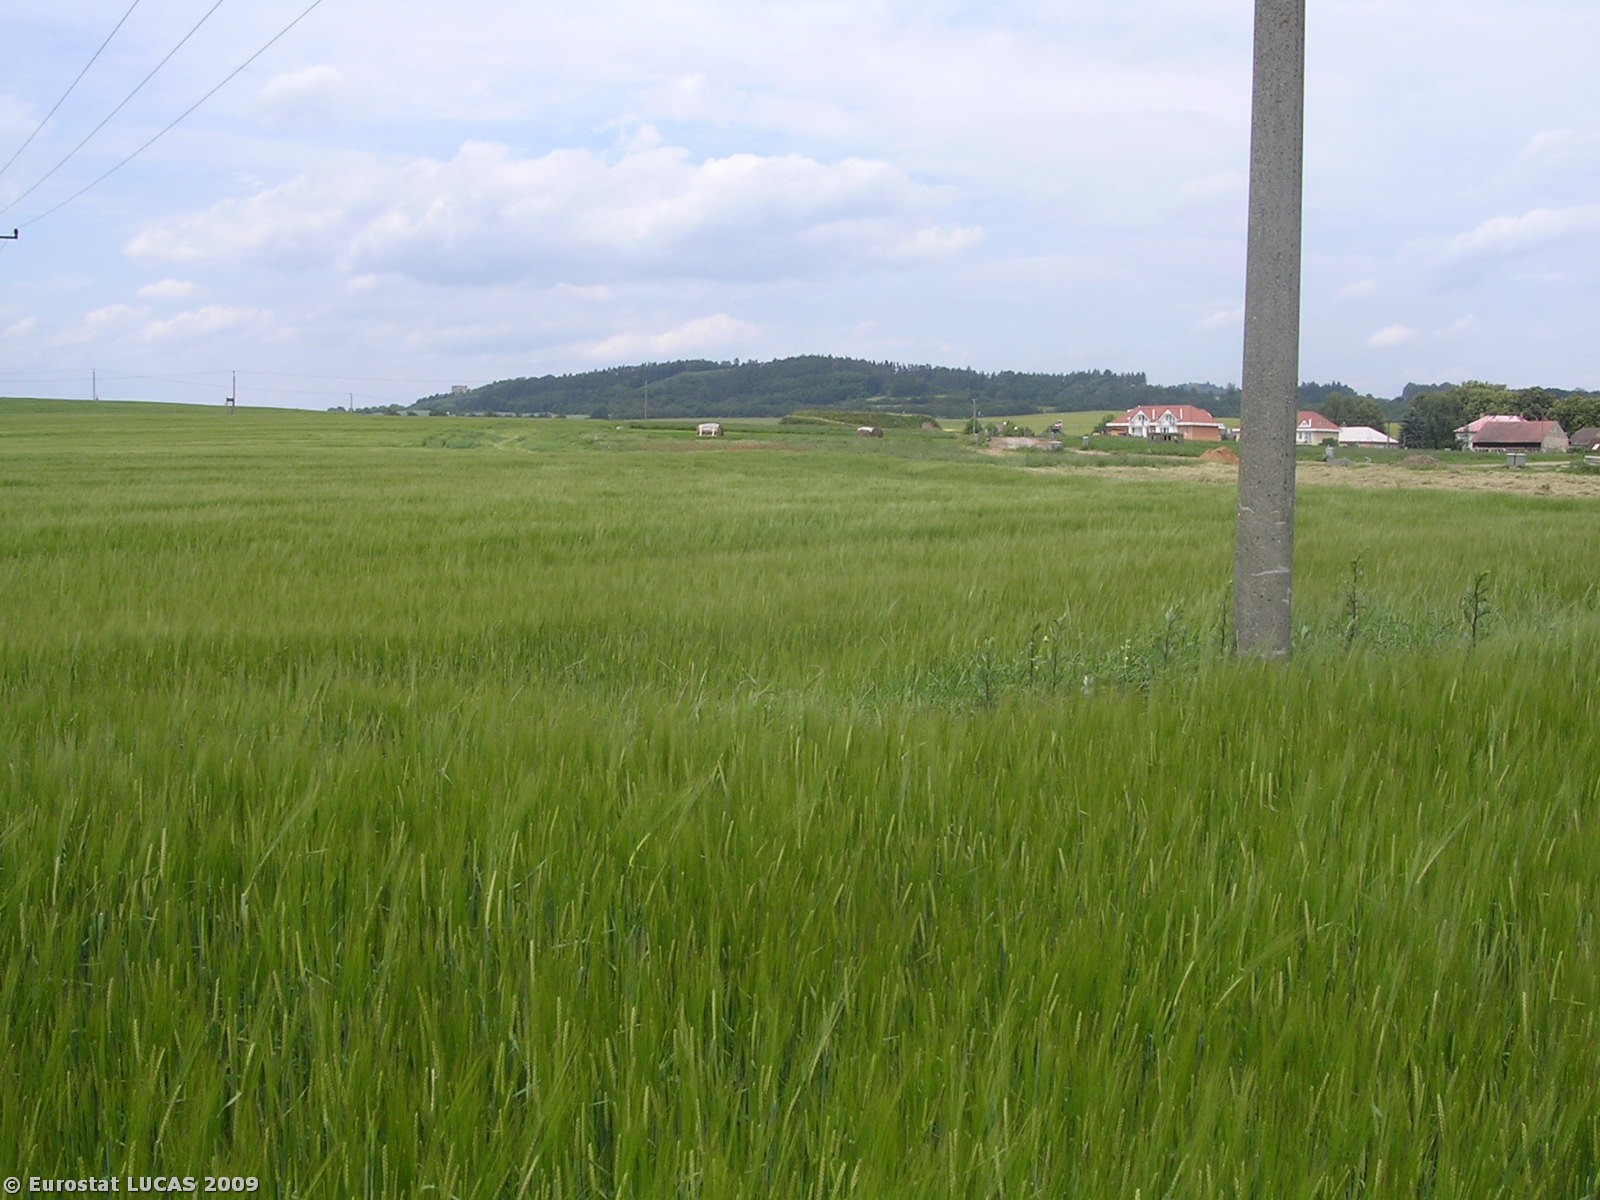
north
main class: Cropland
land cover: Barley
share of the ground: > 75 %
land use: Agriculture (excluding fallow land and kitchen gardens)
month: June
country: CZ
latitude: 50.4875
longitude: 15.0347
